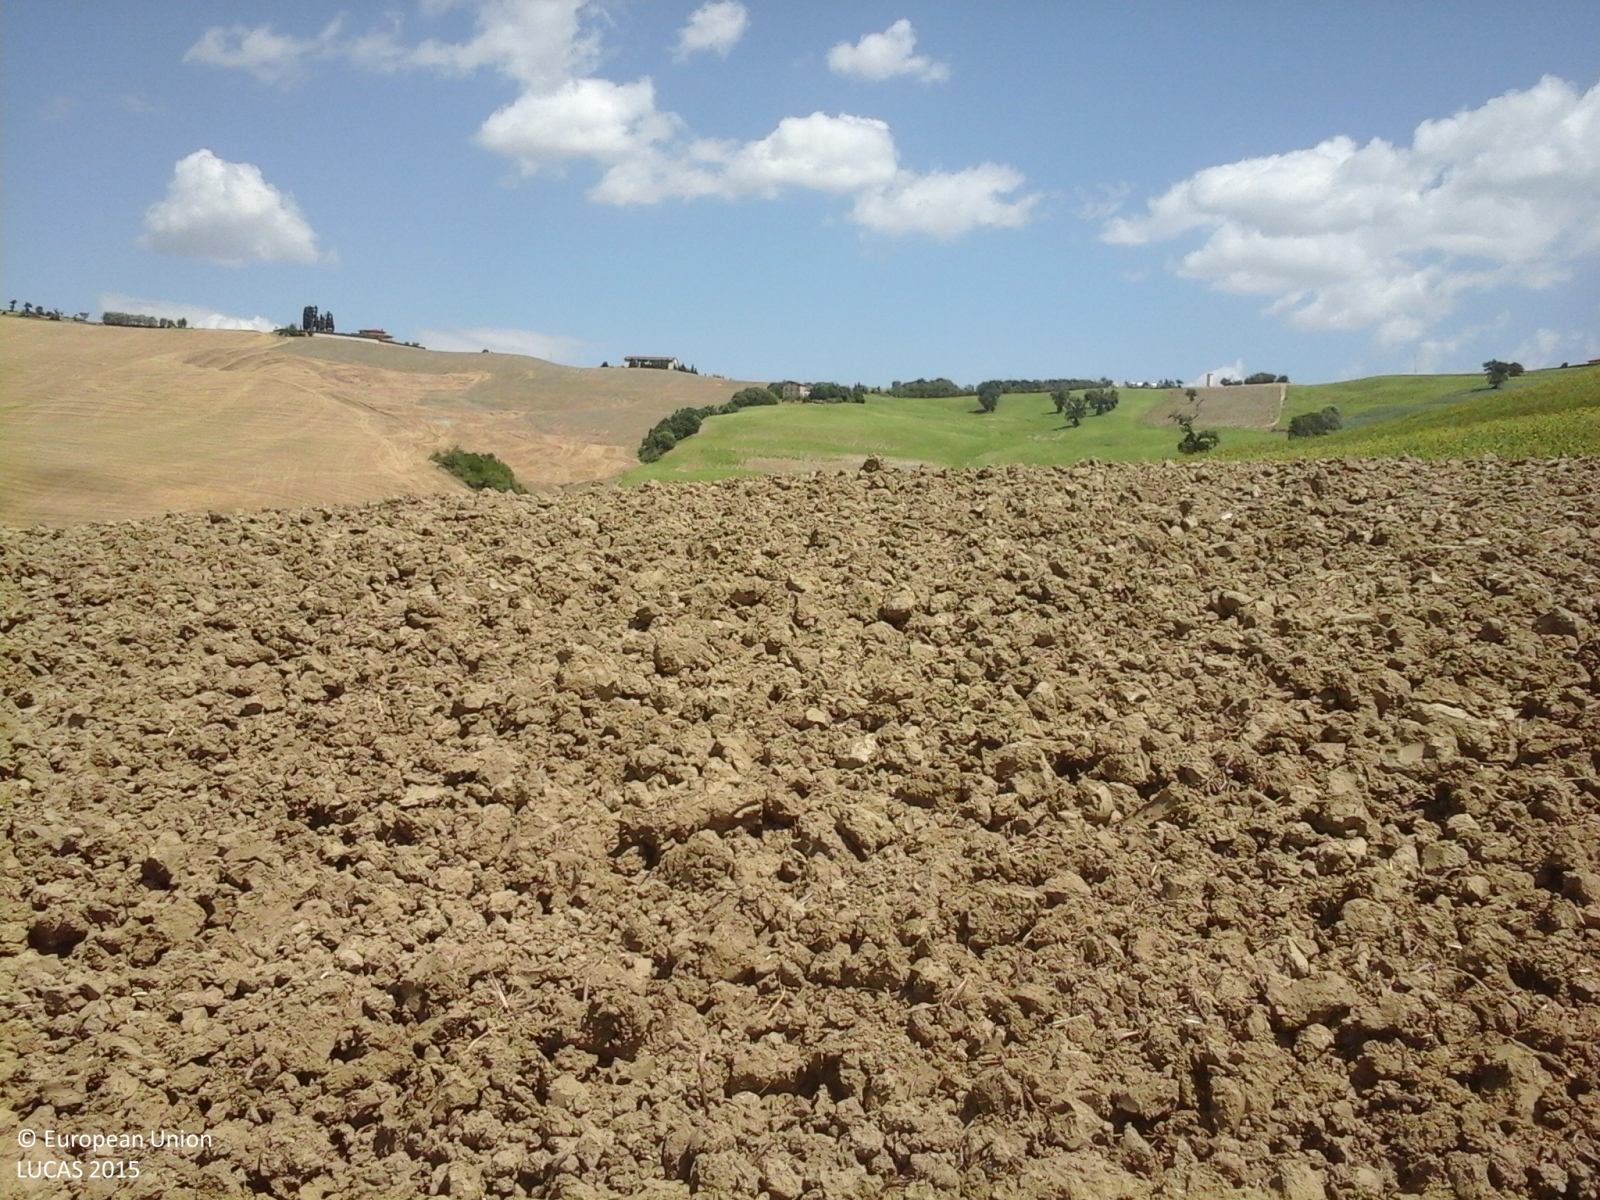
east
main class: Cropland
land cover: Durum wheat
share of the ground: > 75 %
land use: Agriculture (excluding fallow land and kitchen gardens)
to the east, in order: Durum wheat; Sunflower
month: July
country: IT
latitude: 43.2342
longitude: 13.2545
